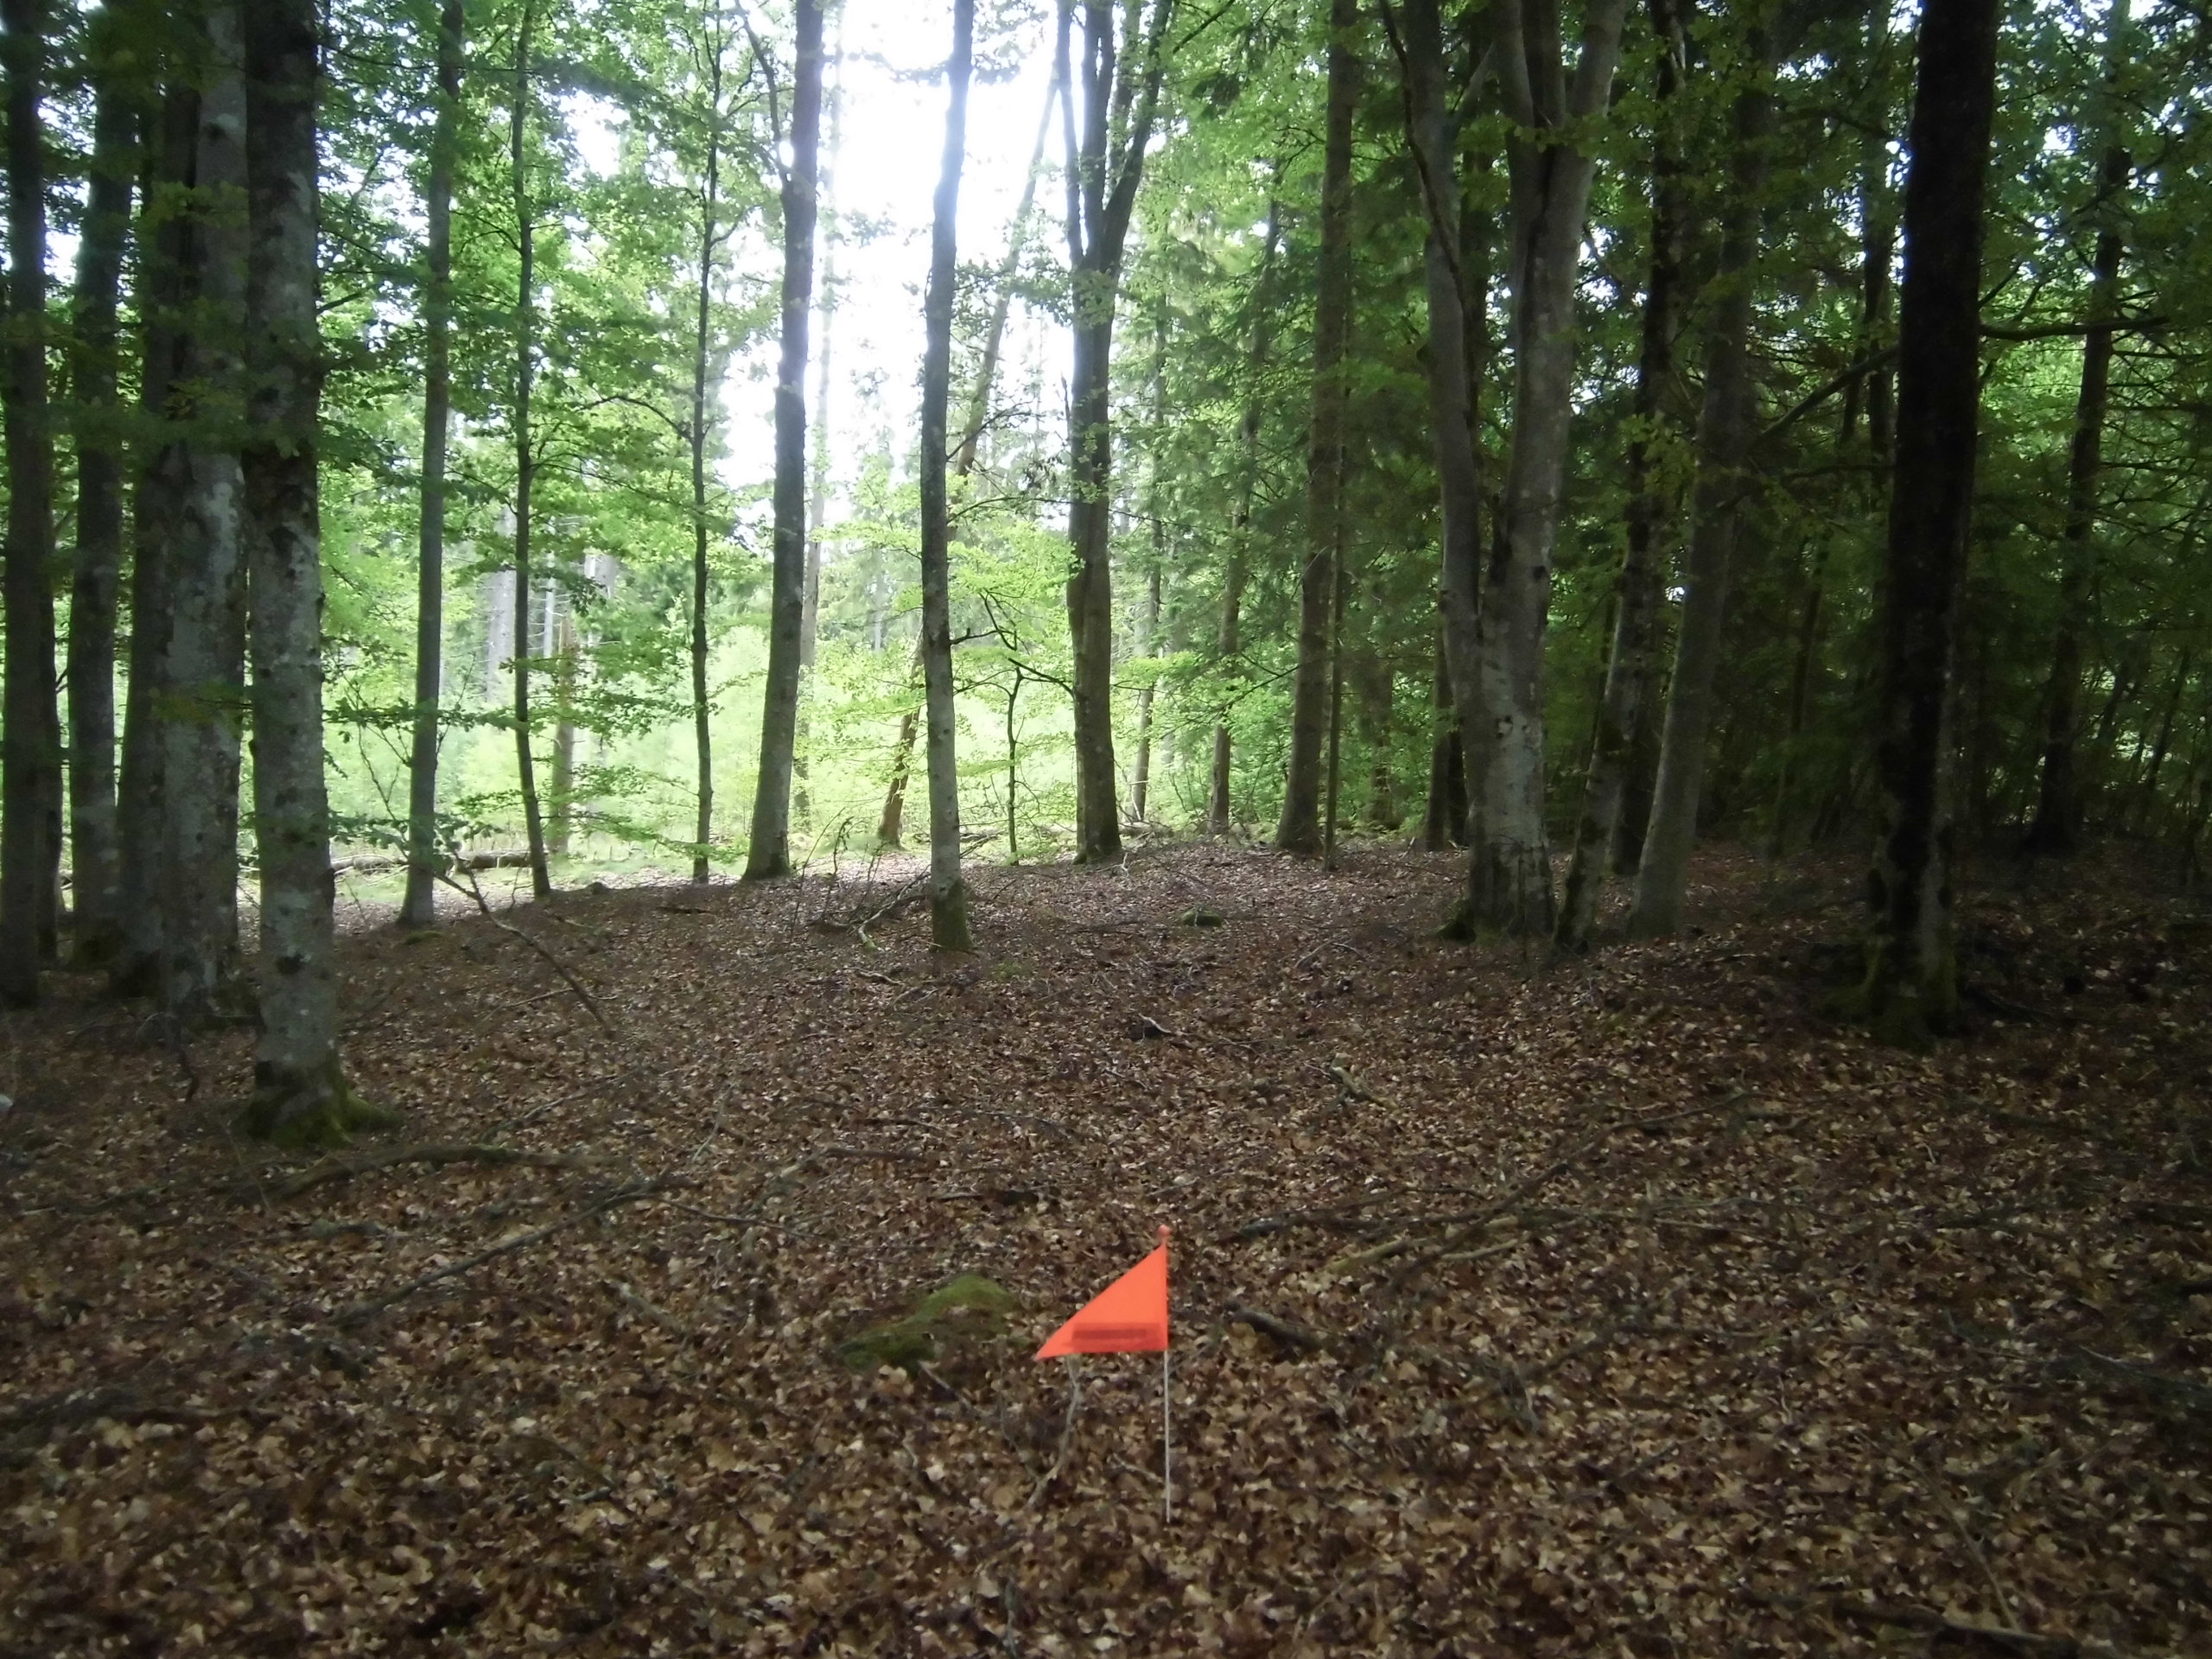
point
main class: Woodland
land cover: Broadleaved woodland
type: beech forest
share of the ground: 50 - 75 %
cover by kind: broadleaved forest trees 75 %, unconsolidated bare surface 15 %, herbaceous plants 5 %, lichens and mosses 5 %
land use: Forestry
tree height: > 5 m
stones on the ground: 25 - 50 %
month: June
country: SE
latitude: 57.0218
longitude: 14.6584
